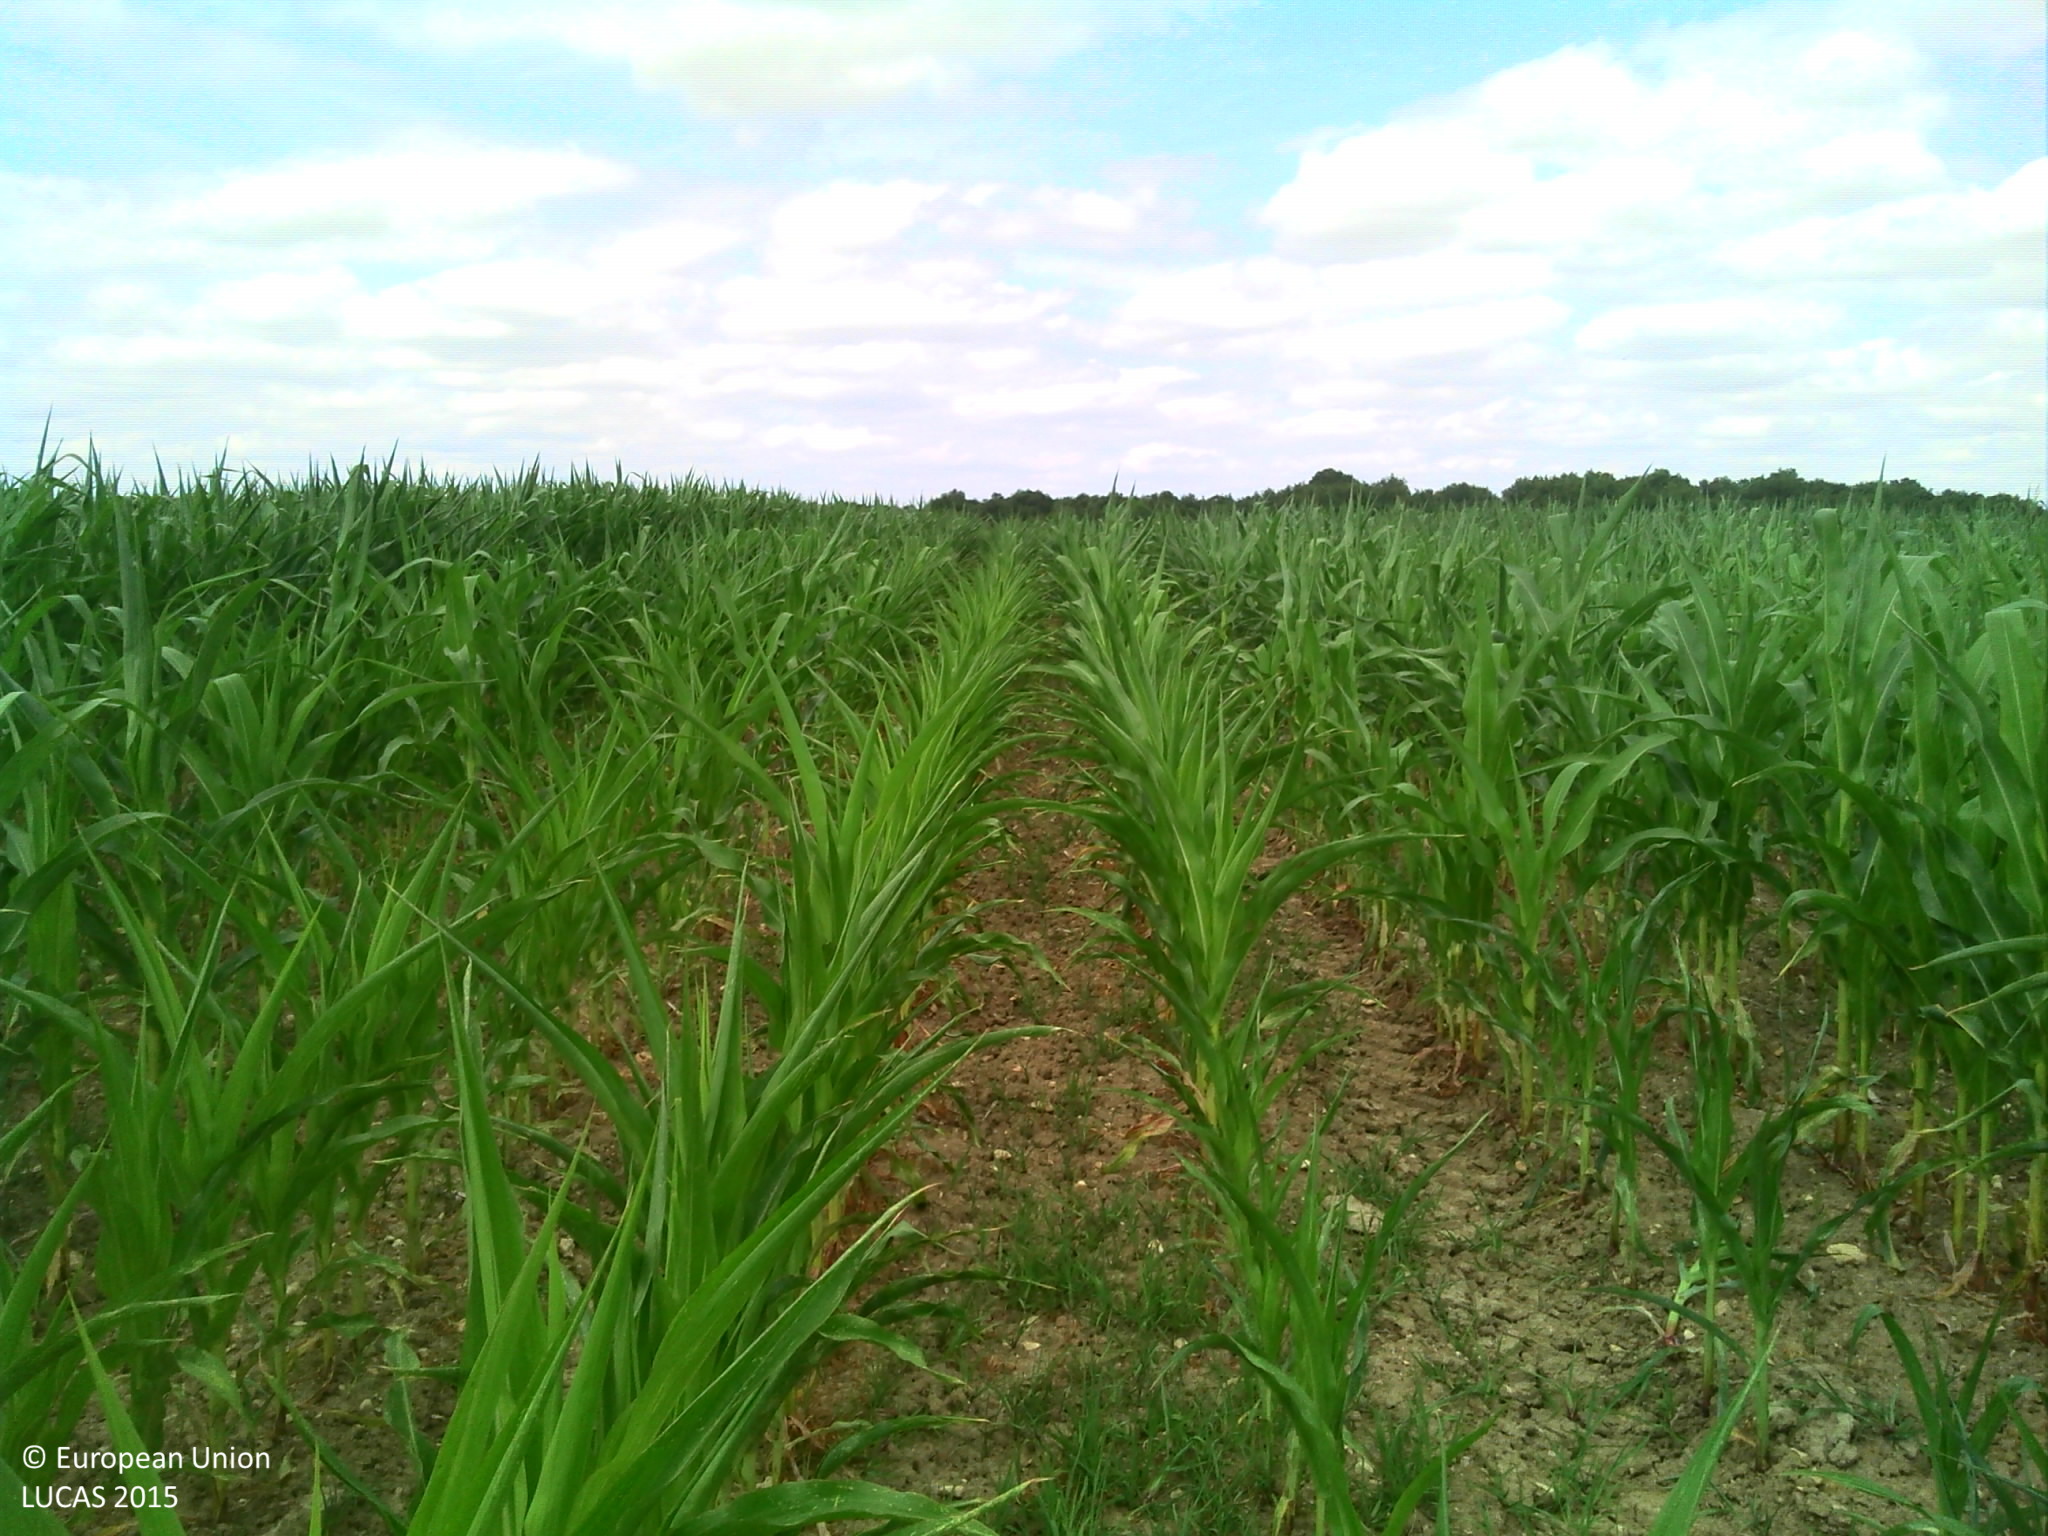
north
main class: Cropland
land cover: Maize
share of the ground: 50 - 75 %
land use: Agriculture (excluding fallow land and kitchen gardens)
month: July
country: FR
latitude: 47.1598
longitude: 0.4959
